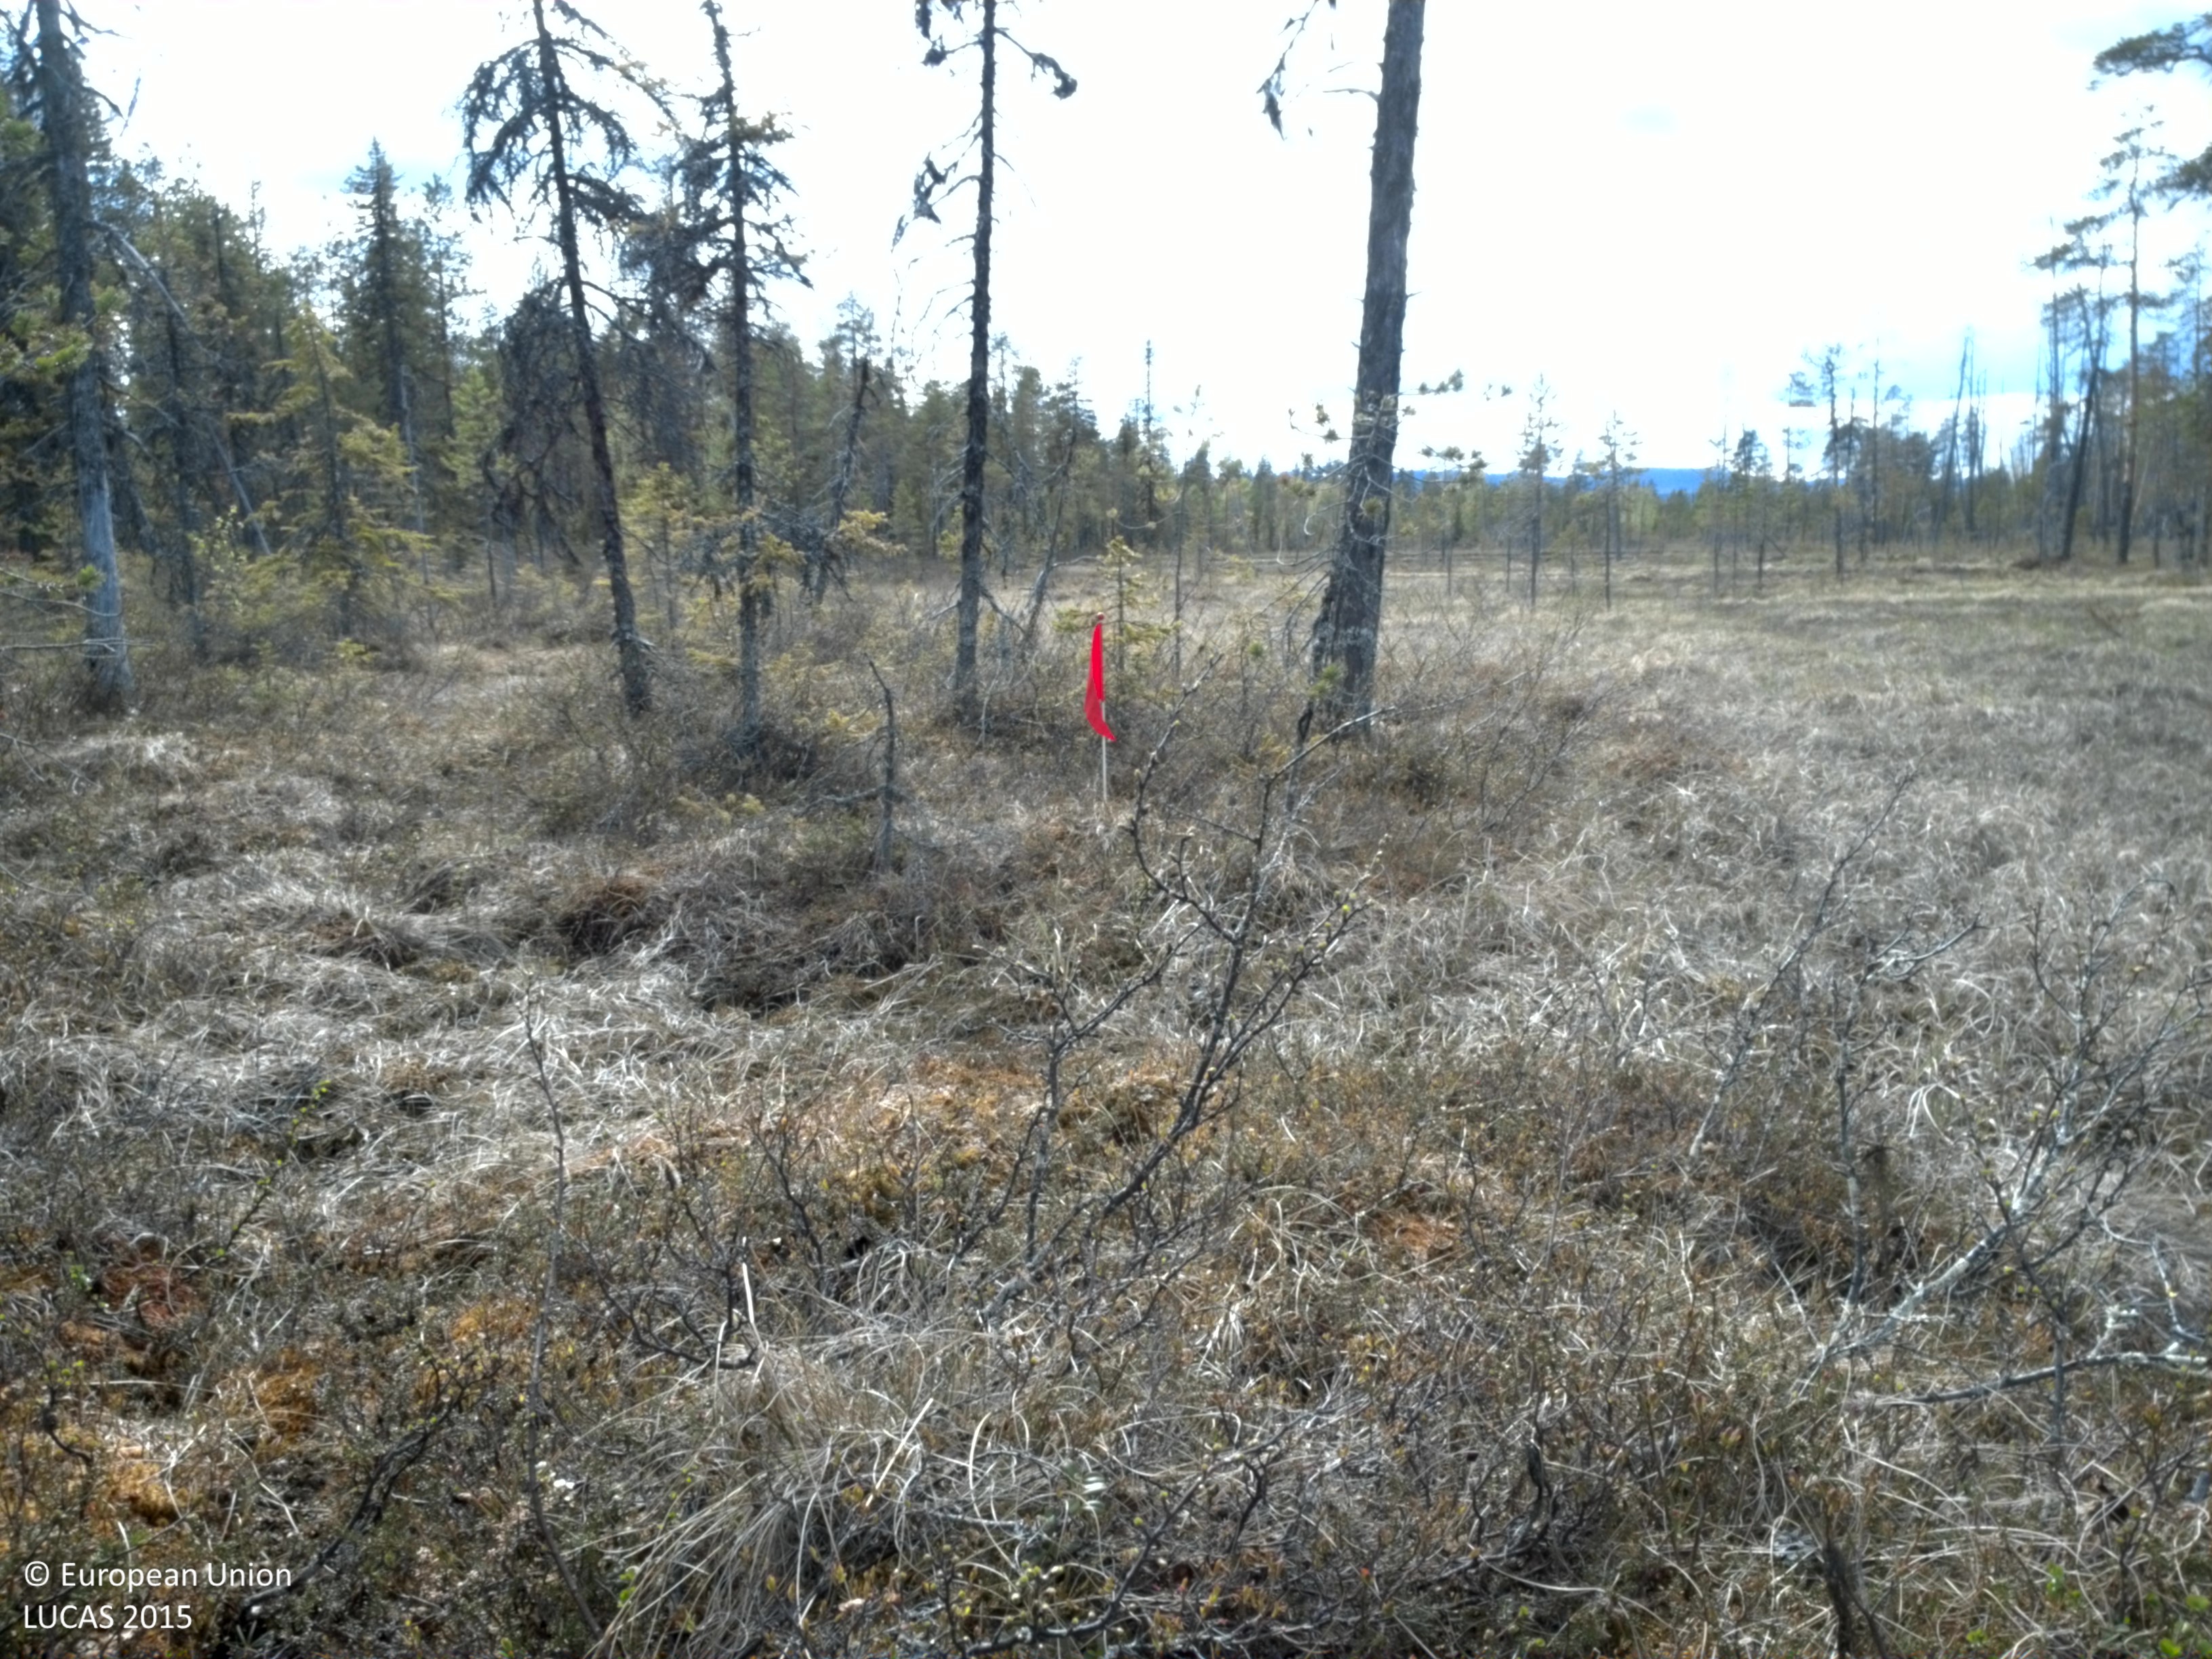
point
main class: Woodland
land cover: Spruce dominated coniferous woodland
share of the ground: 10 - 25 %
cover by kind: shrubs 60 %, herbaceous plants 20 %, coniferous forest trees 15 %, lichens and mosses 5 %
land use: Semi-natural and natural areas not in use
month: June
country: SE
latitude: 66.1741
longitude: 18.8060
